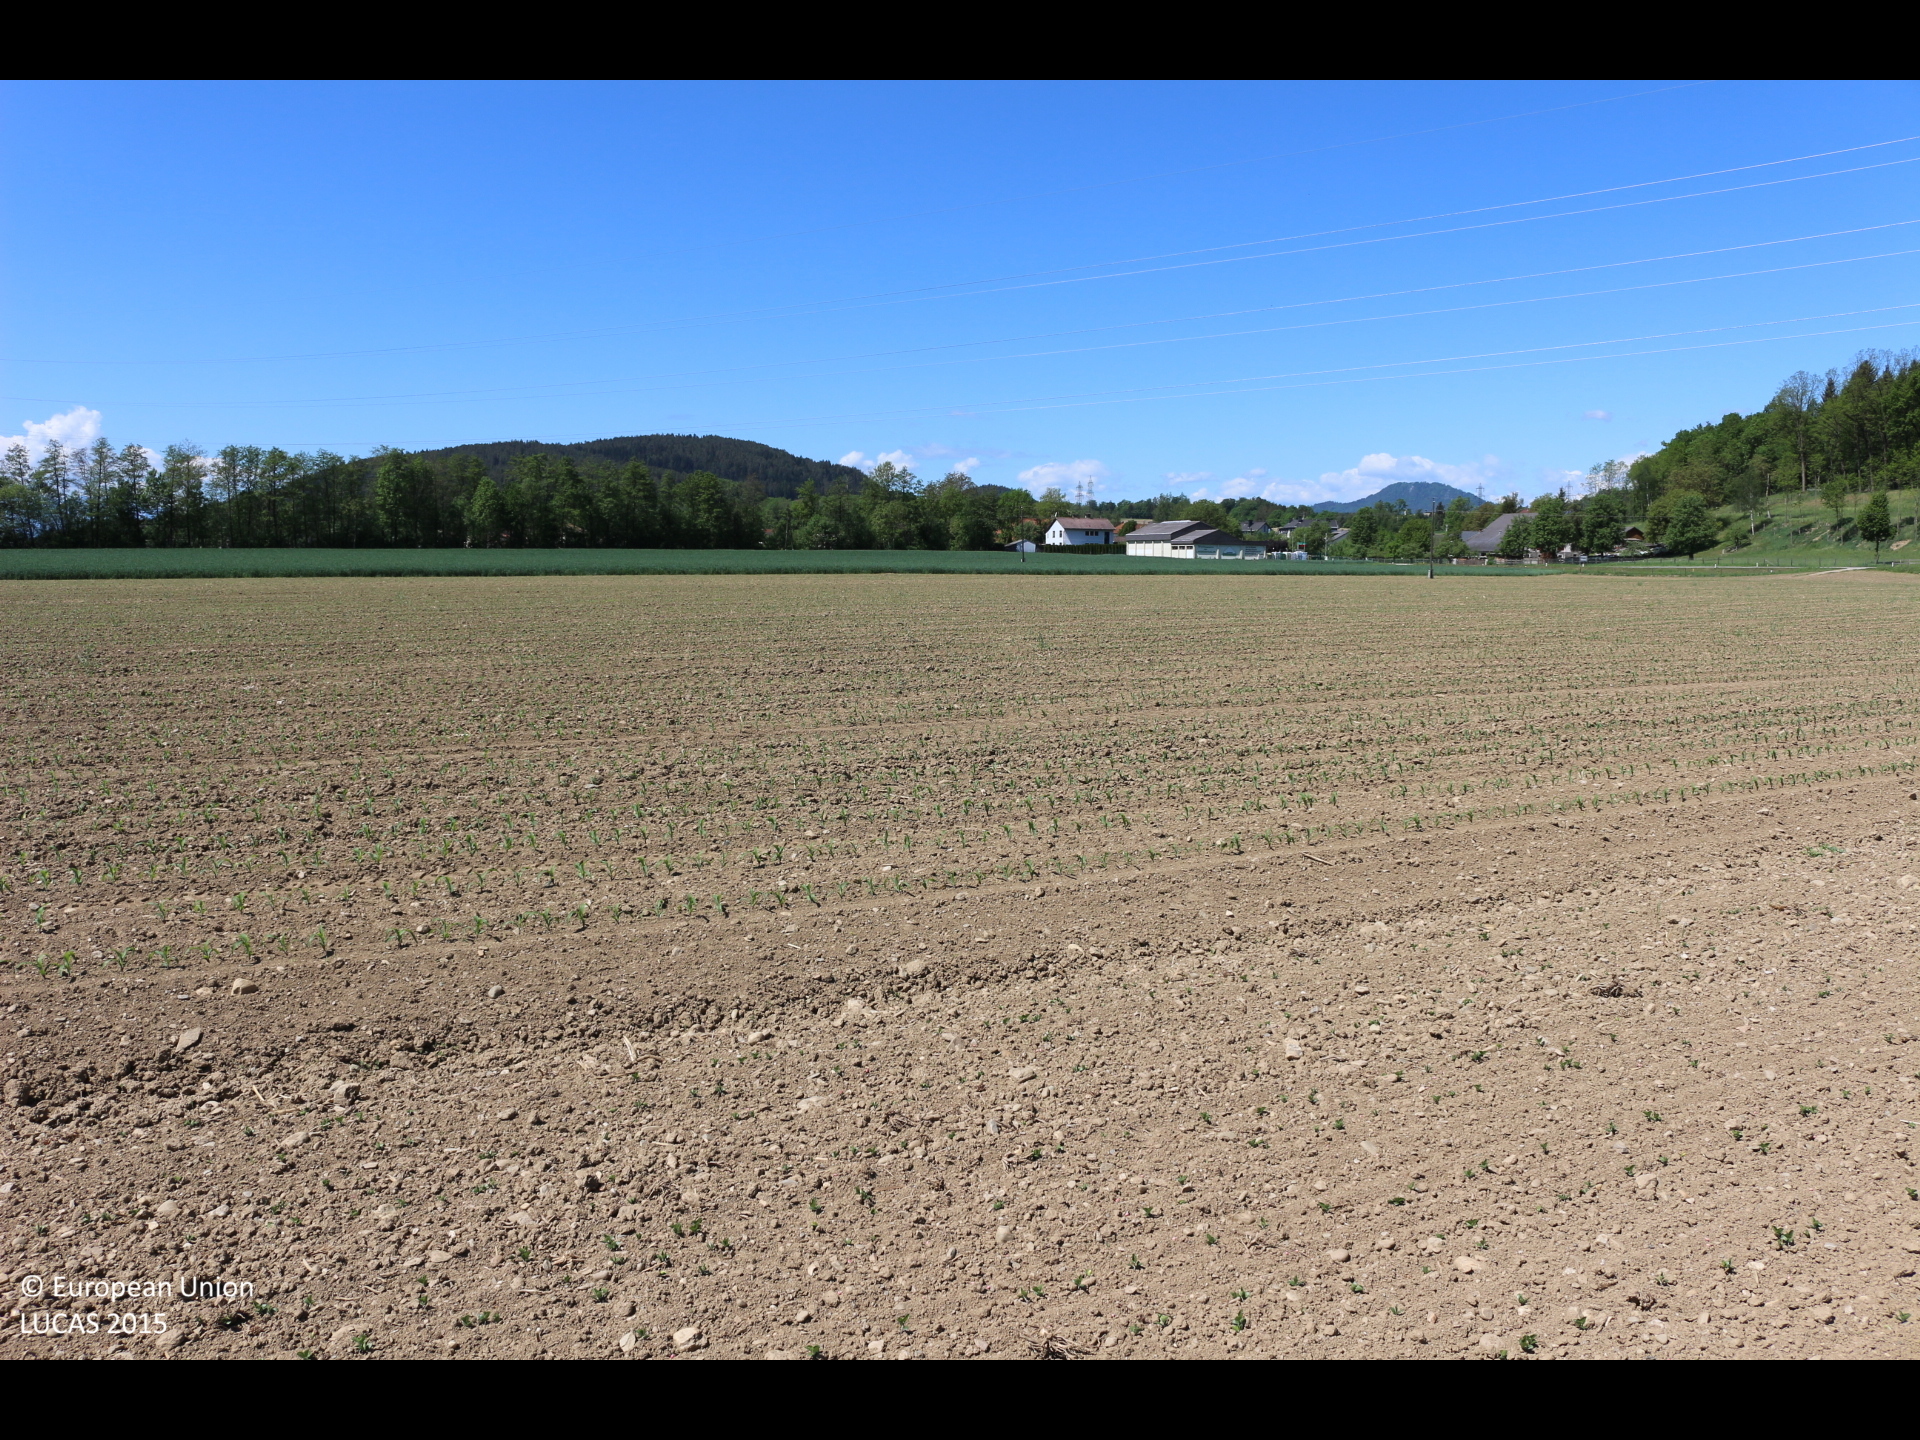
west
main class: Cropland
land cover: Soya
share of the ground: < 10 %
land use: Agriculture (excluding fallow land and kitchen gardens)
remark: Tilled/Sowed
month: May
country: AT
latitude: 46.6743
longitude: 14.4291
